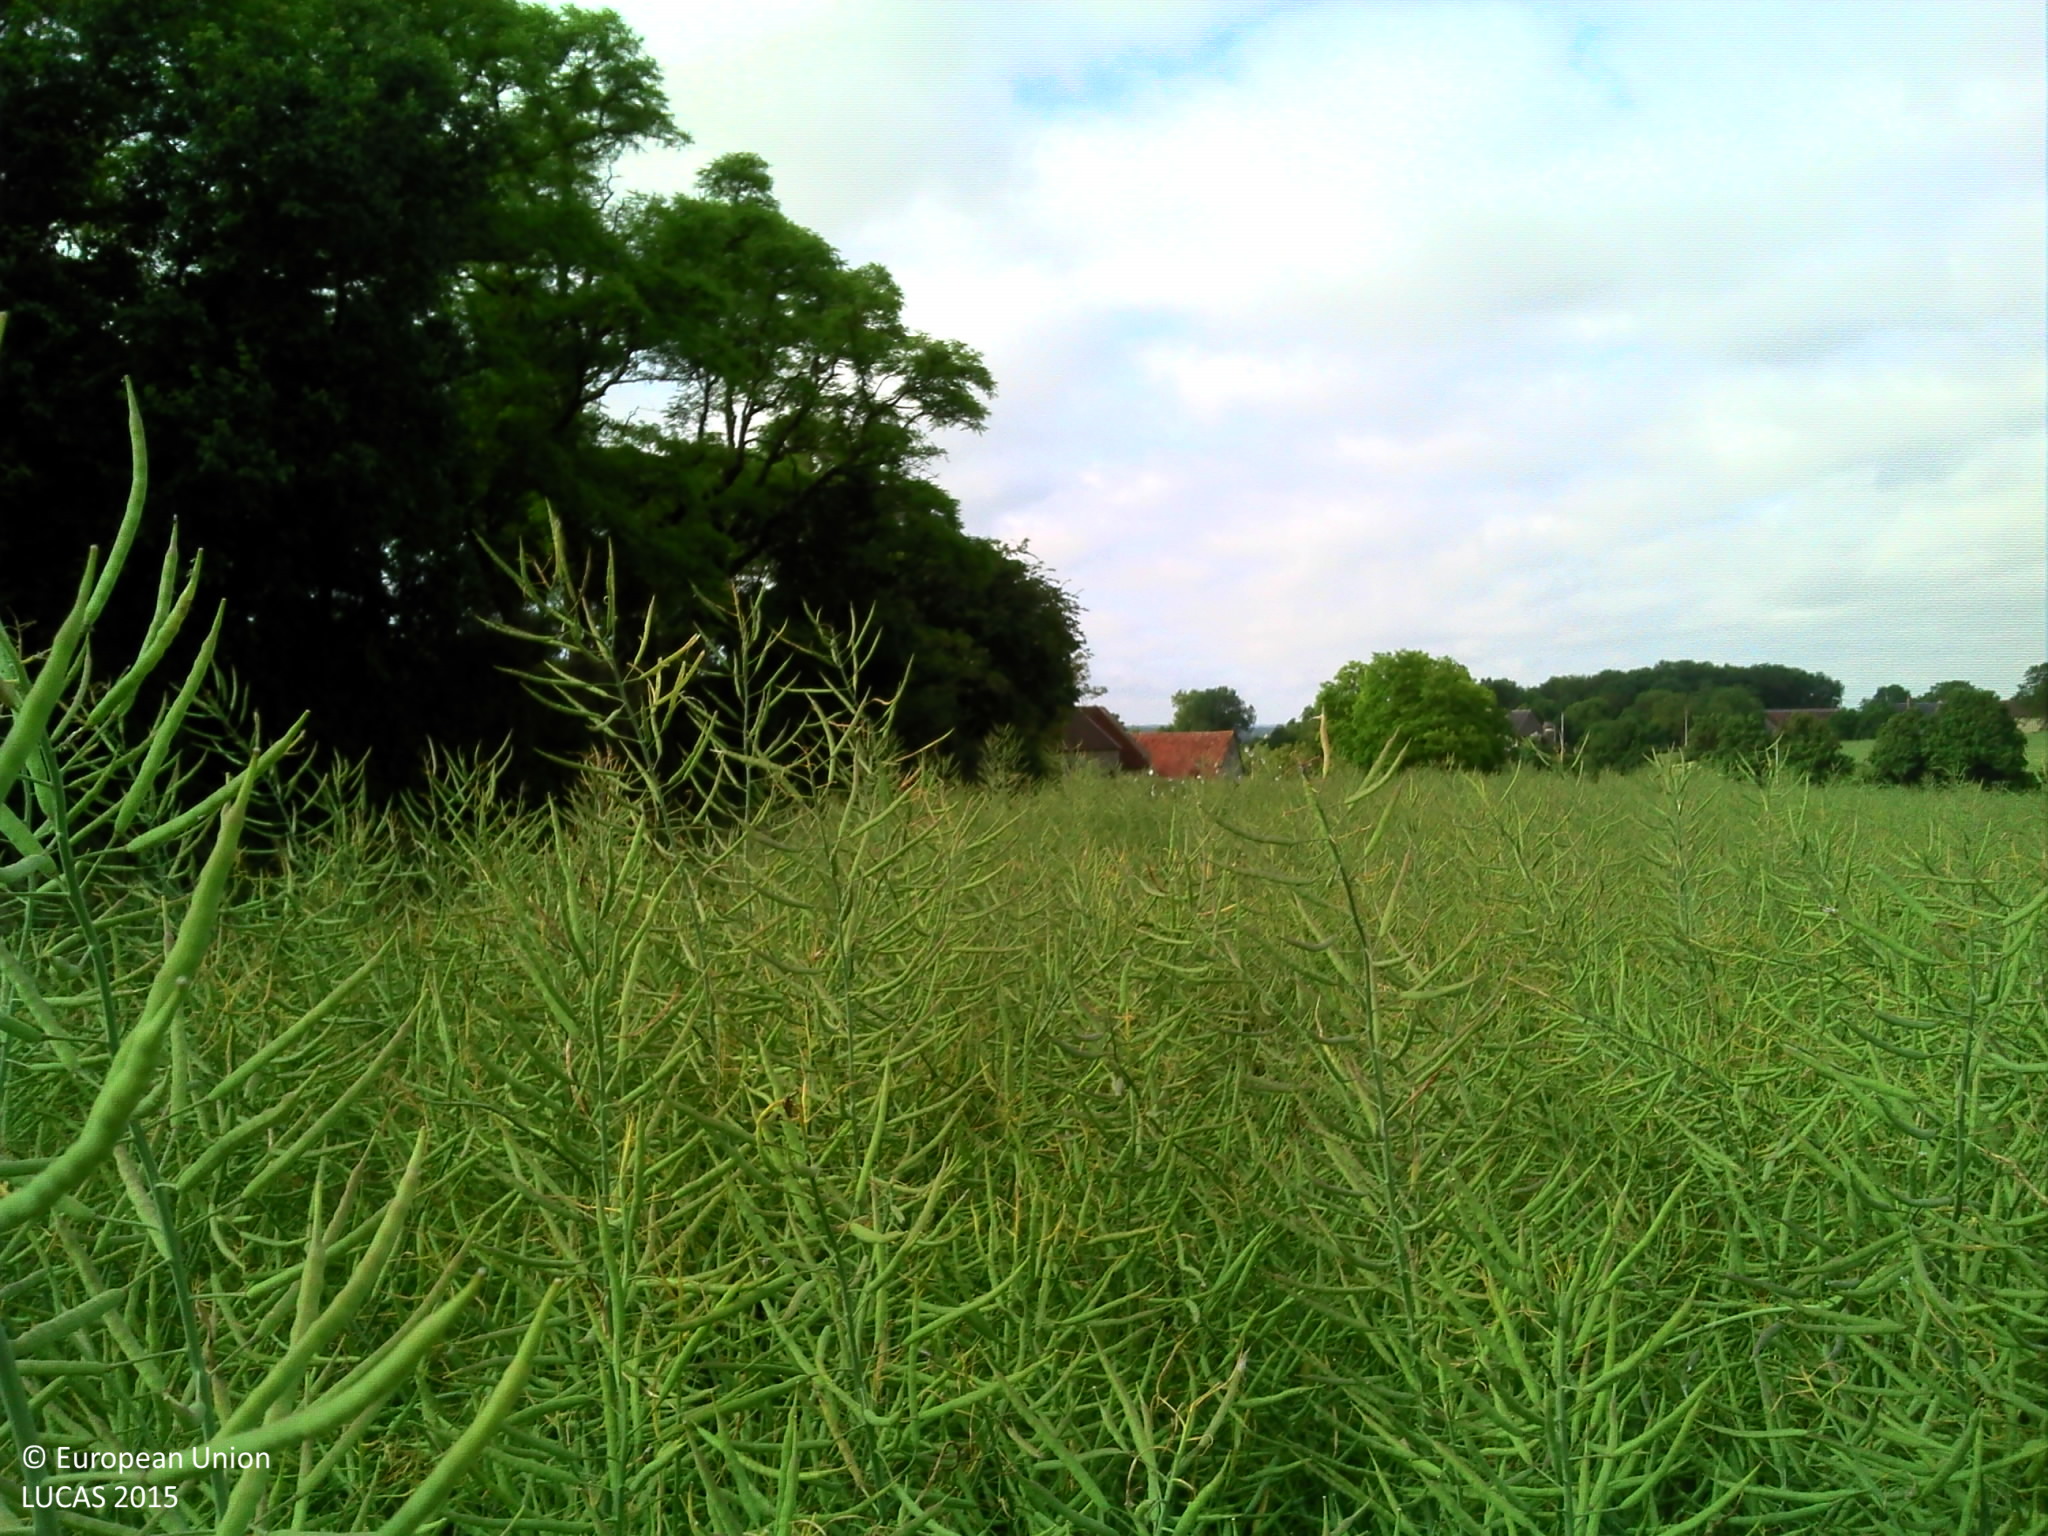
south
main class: Cropland
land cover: Rape and turnip rape
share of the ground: > 75 %
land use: Agriculture (excluding fallow land and kitchen gardens)
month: June
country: FR
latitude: 46.9336
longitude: 2.7047
